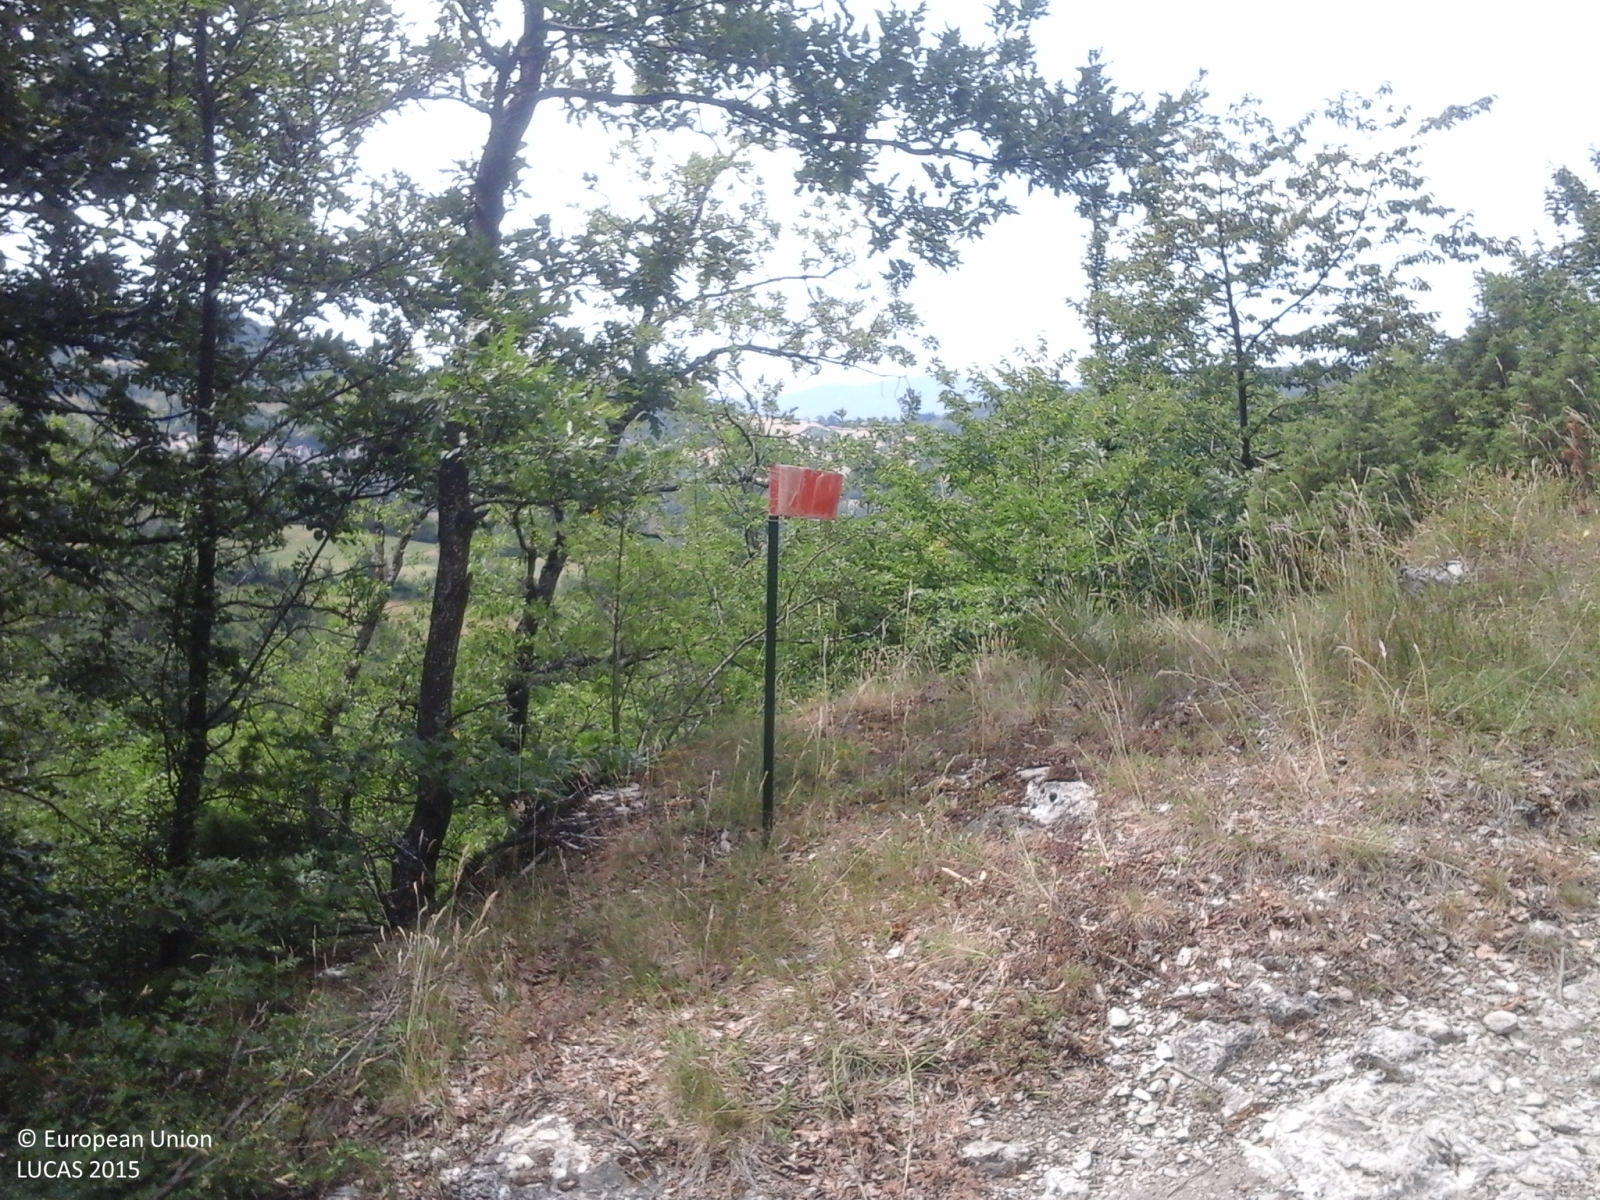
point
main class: Woodland
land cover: Broadleaved woodland
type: thermophilous deciduous forest
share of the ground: > 75 %
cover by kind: broadleaved forest trees 100 %
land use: Forestry
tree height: > 5 m
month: July
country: IT
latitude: 44.4043
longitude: 10.2881
